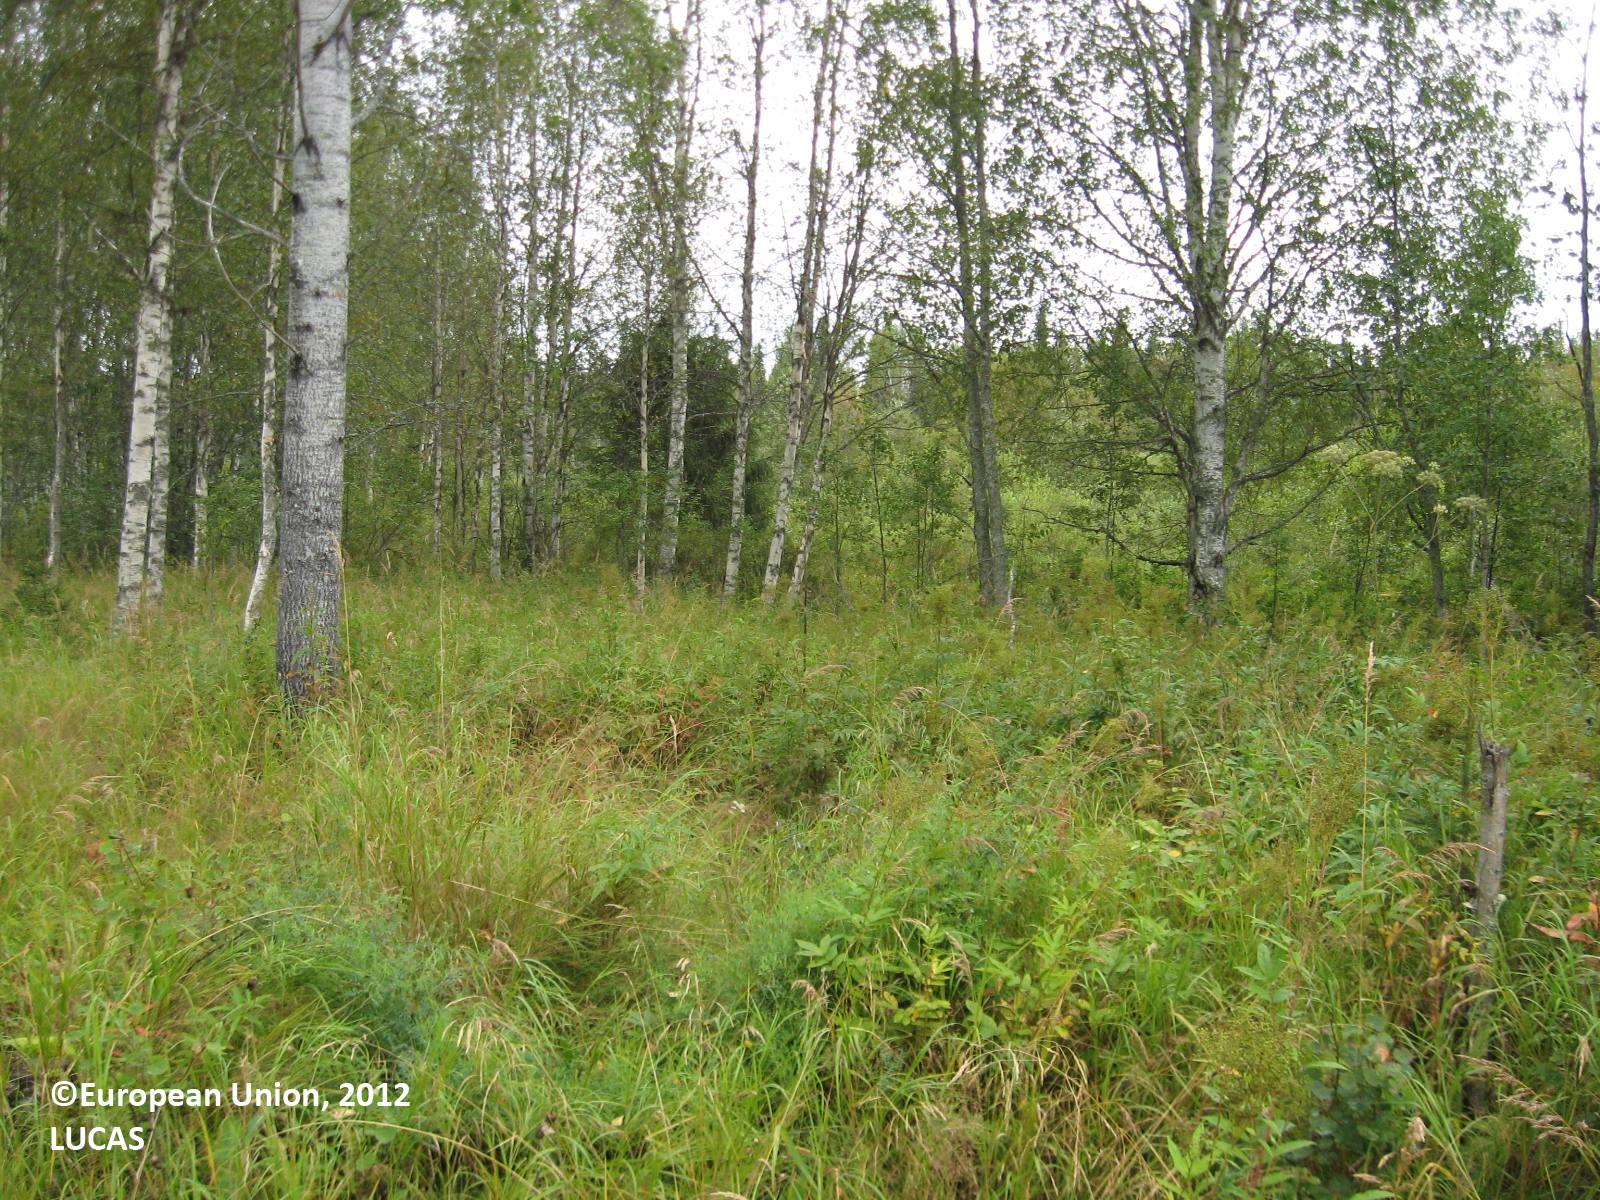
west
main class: Woodland
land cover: Broadleaved woodland
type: boreal forest
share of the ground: 25 - 50 %
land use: Forestry
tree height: > 5 m
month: August
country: FI
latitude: 63.6851
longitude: 29.1141
